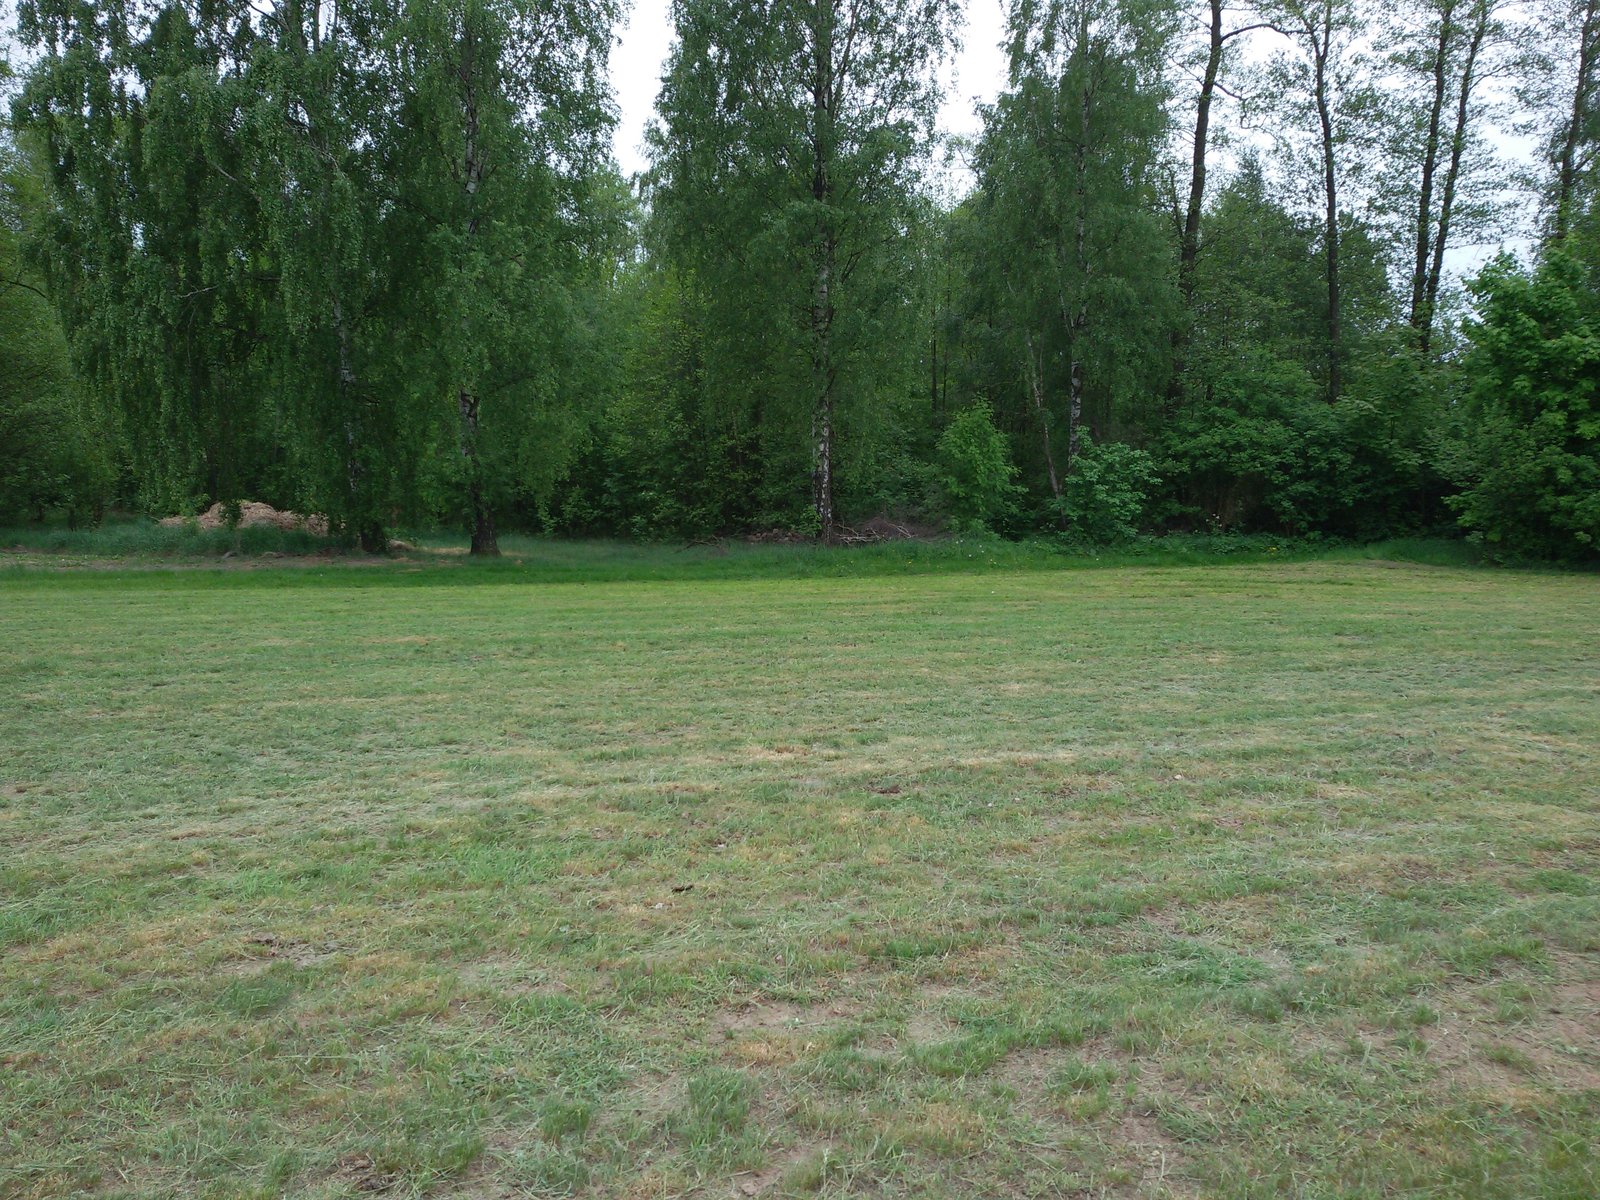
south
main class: Grassland
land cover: Grassland without tree/shrub cover
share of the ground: > 75 %
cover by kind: herbaceous plants 100 %
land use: Agriculture (excluding fallow land and kitchen gardens)
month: May
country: PL
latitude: 52.9878
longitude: 21.0228
